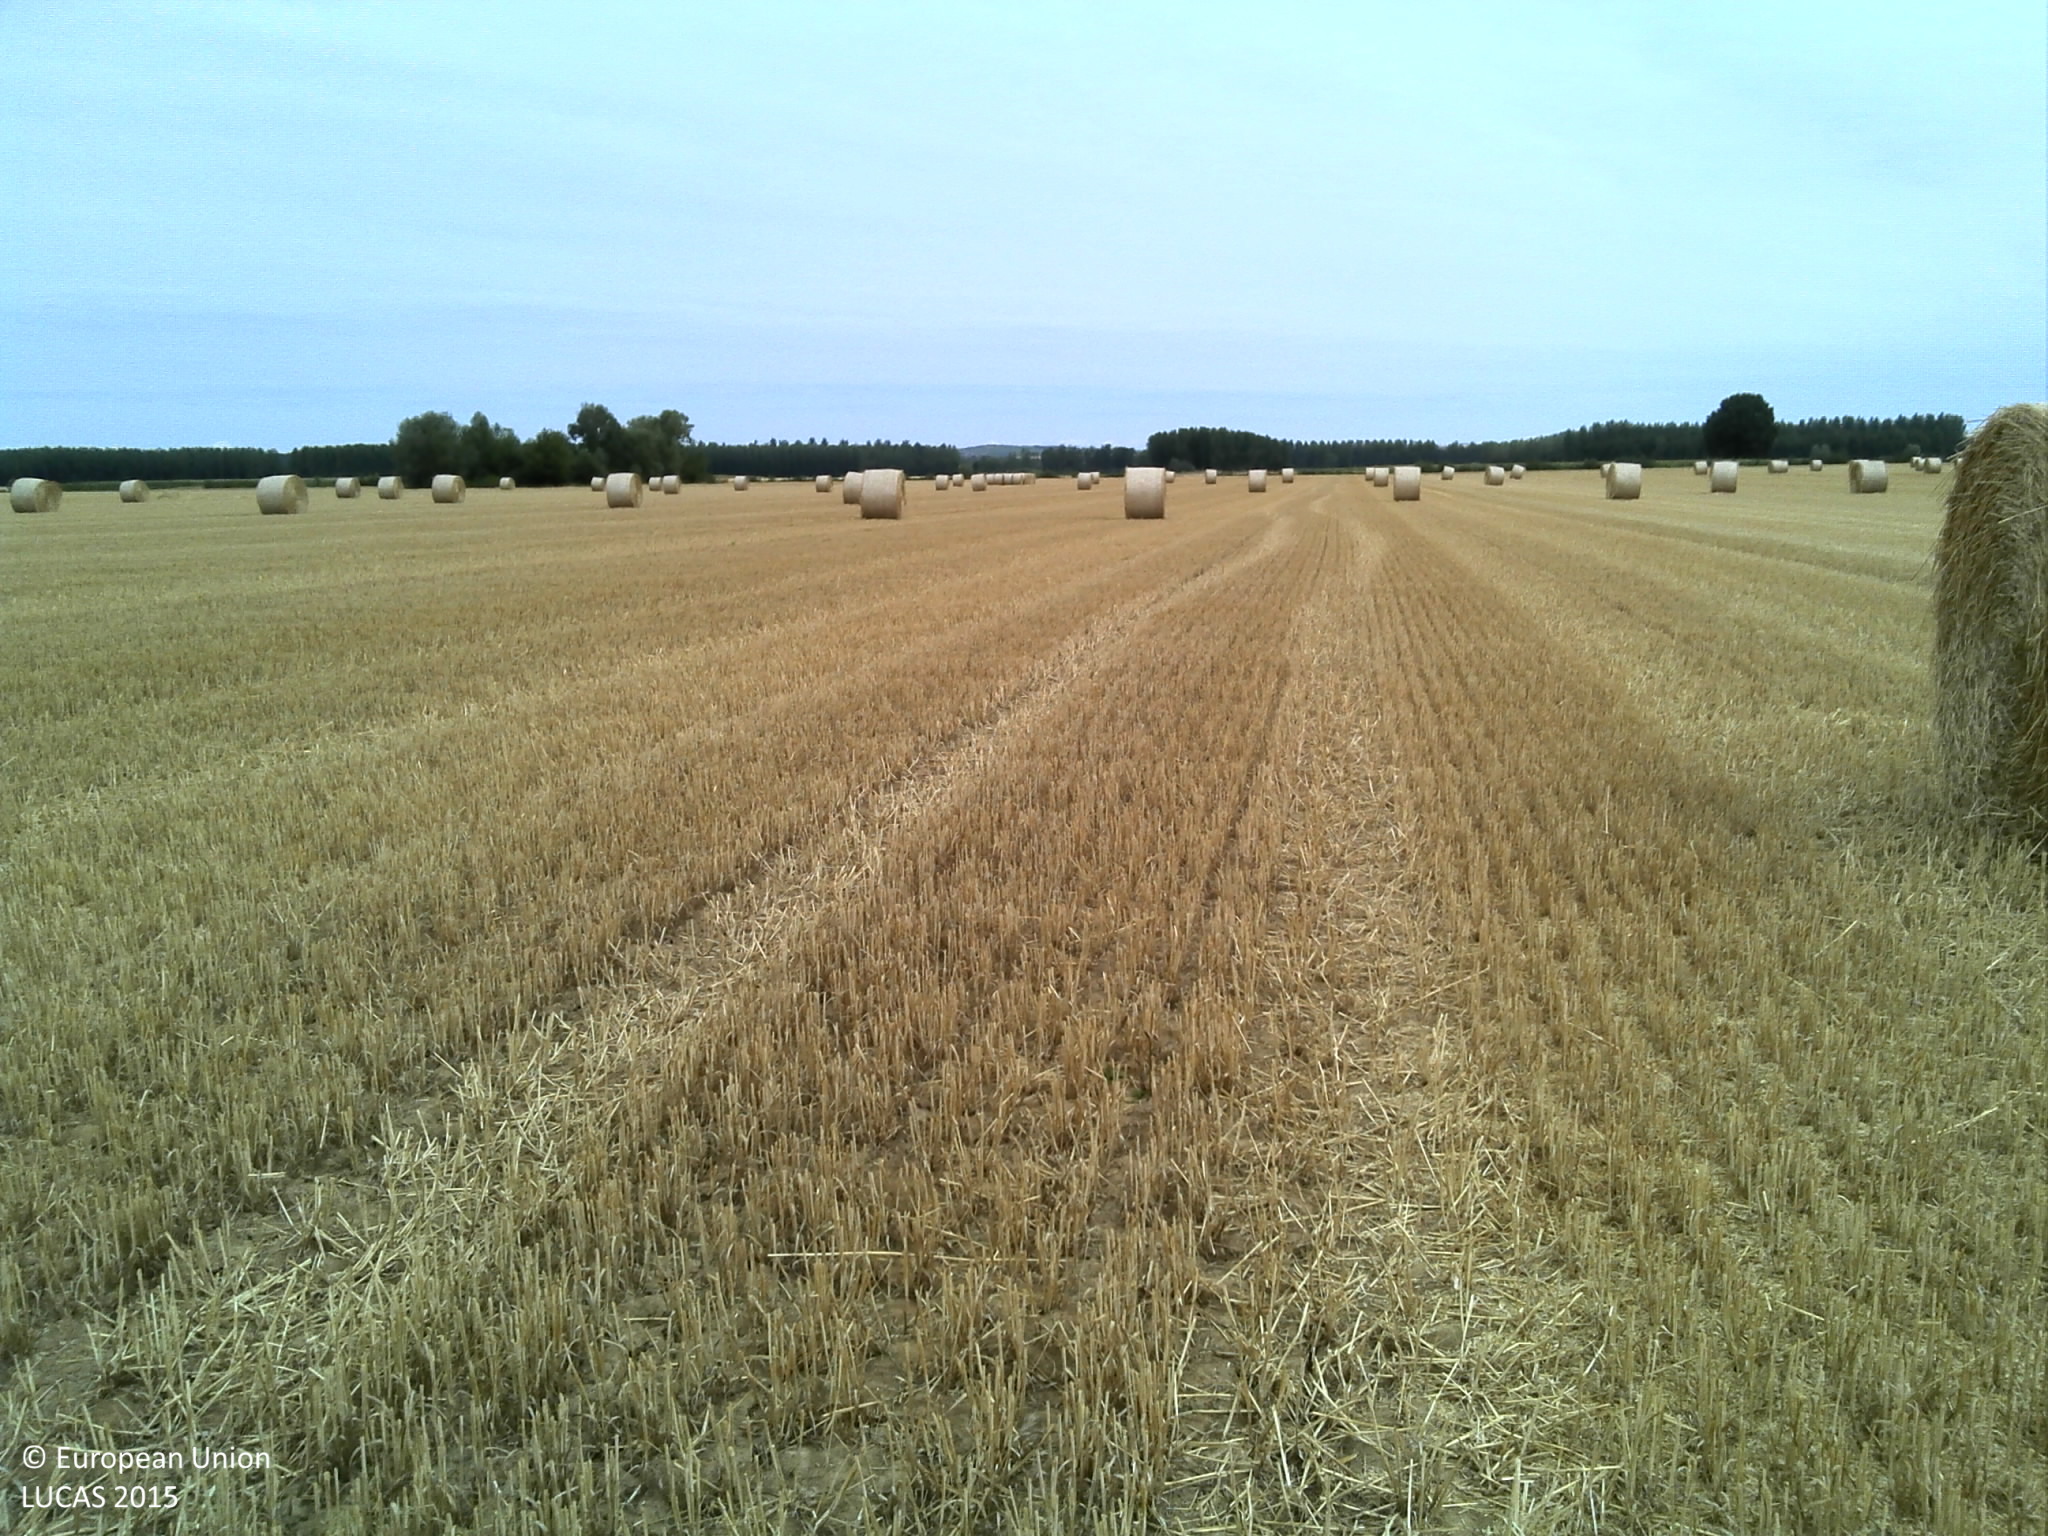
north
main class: Cropland
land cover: Common wheat
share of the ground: > 75 %
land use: Agriculture (excluding fallow land and kitchen gardens)
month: July
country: FR
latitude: 48.7263
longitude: 4.6820
